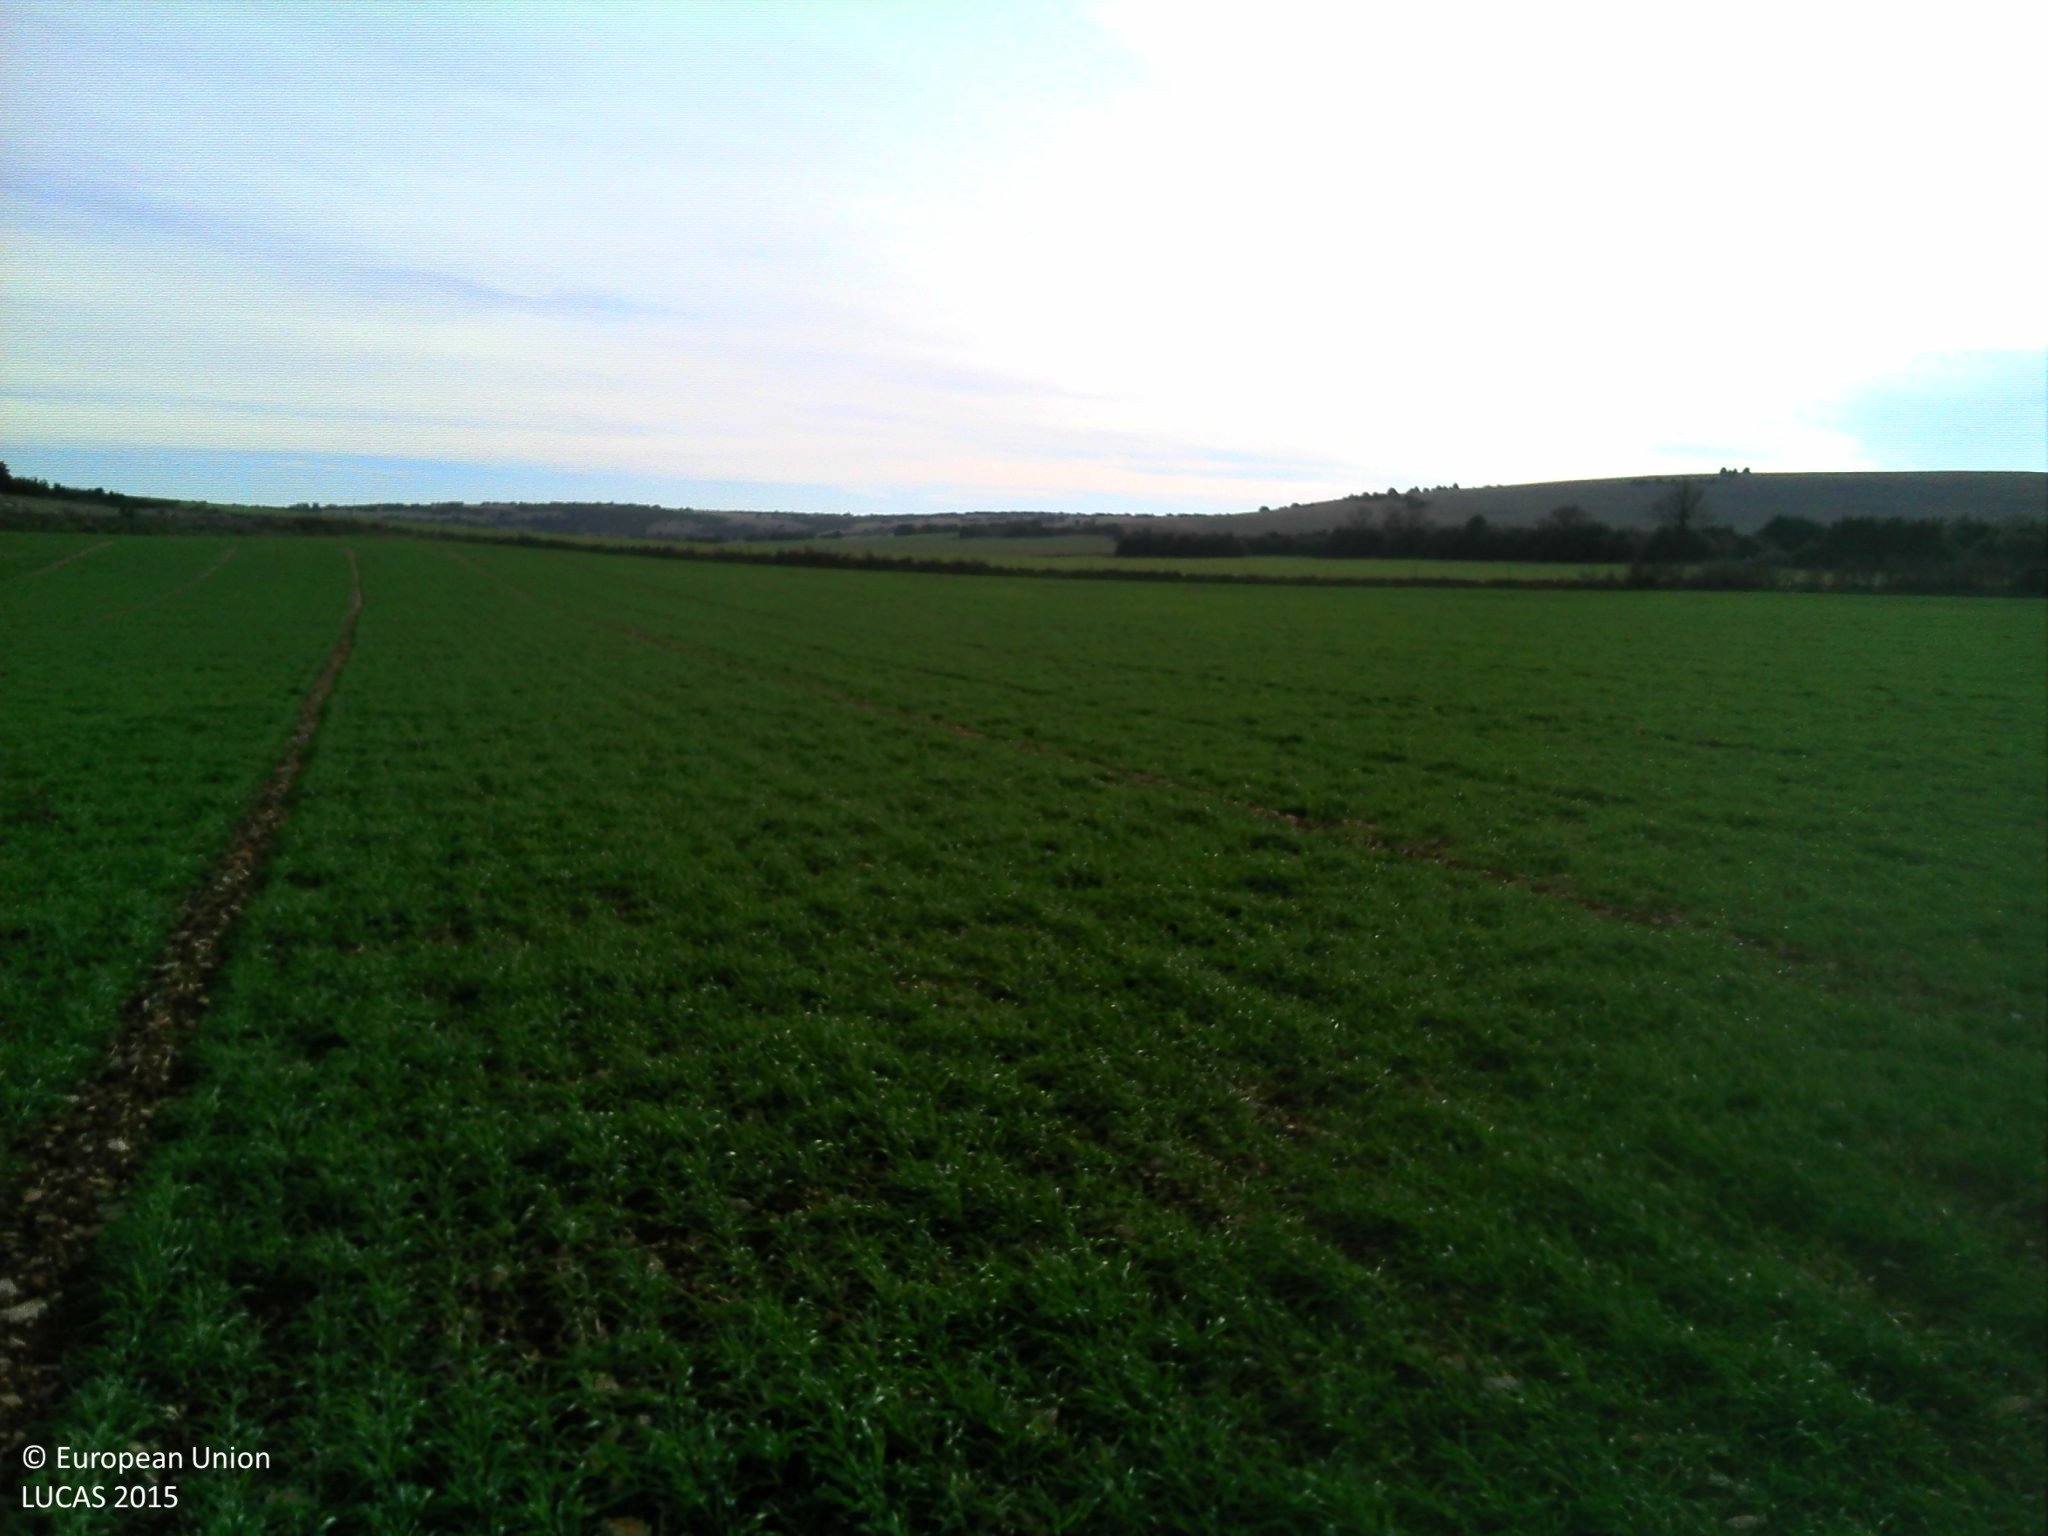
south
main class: Cropland
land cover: Barley
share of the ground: > 75 %
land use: Agriculture (excluding fallow land and kitchen gardens)
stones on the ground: 25 - 50 %
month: November
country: FR
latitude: 44.0487
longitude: 3.1041
